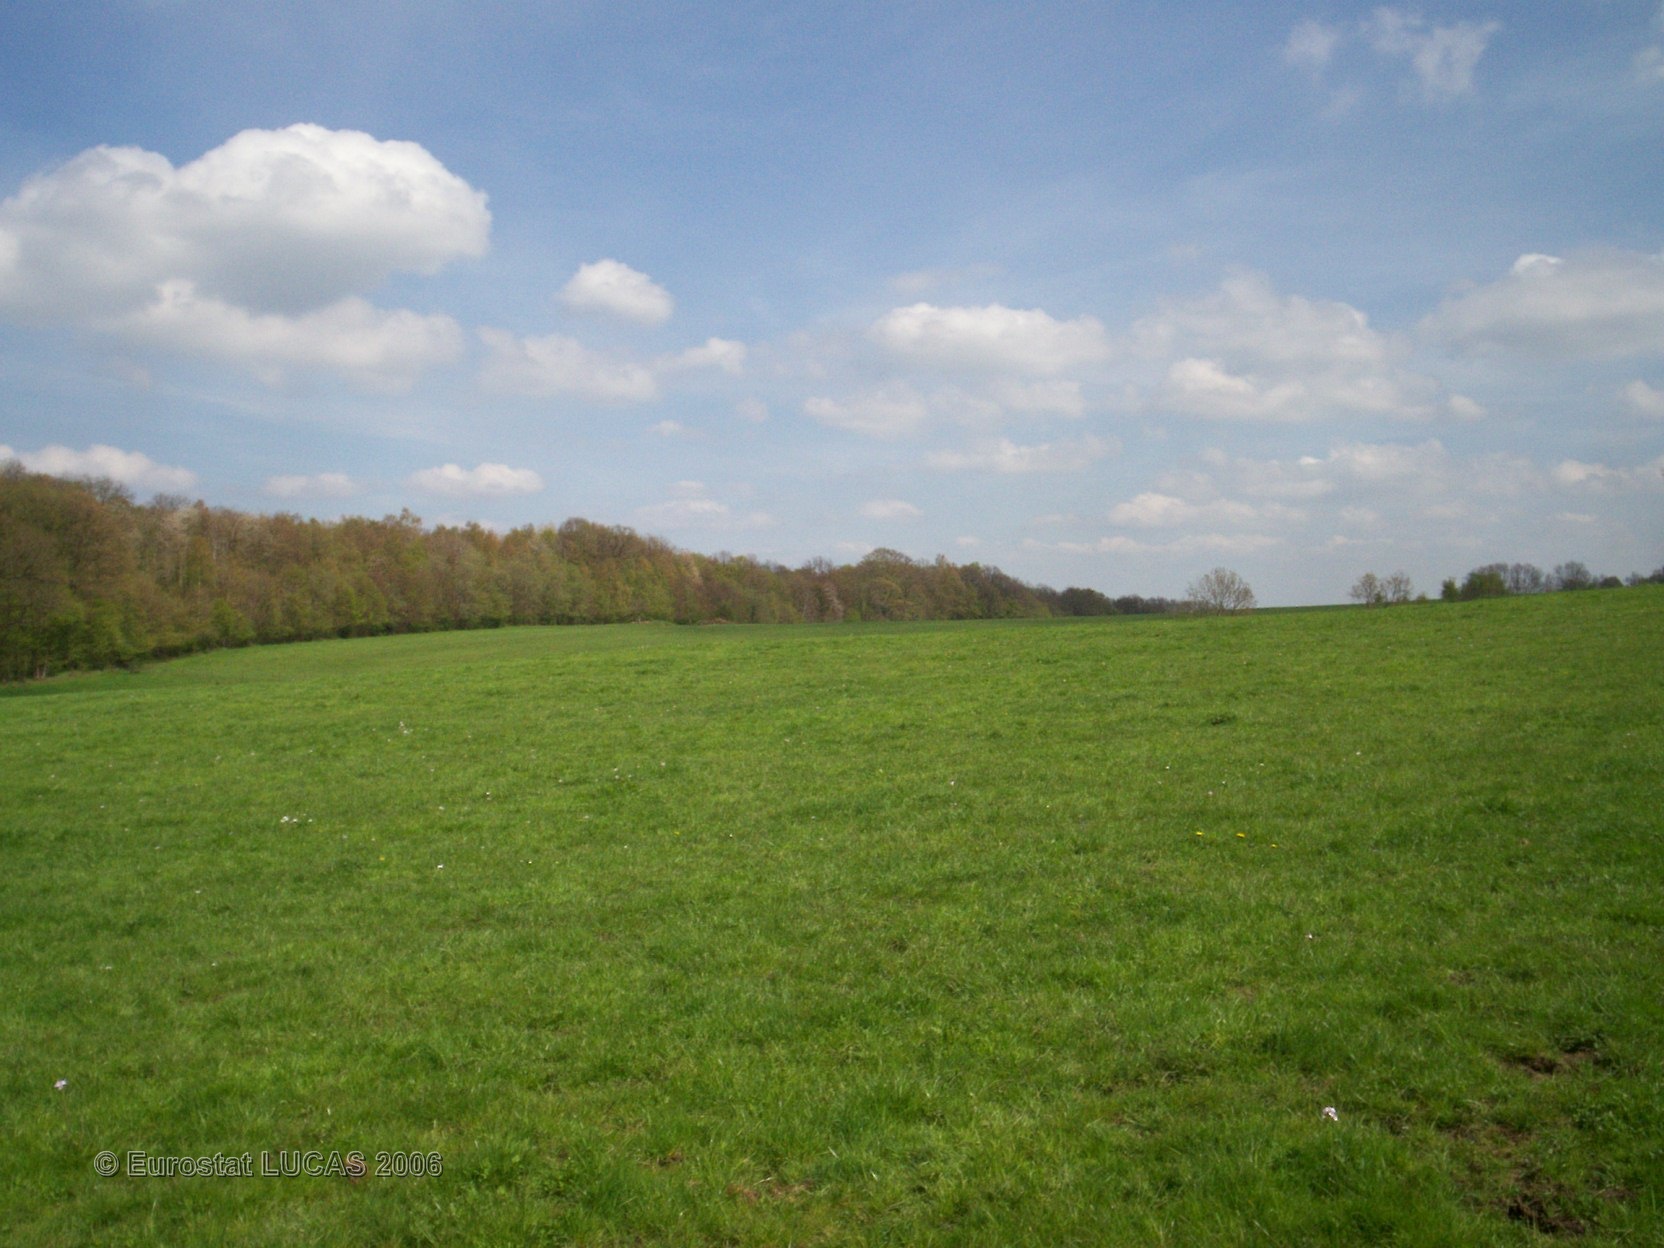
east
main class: Grassland
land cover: Grassland without tree/shrub cover
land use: Agriculture (excluding fallow land and kitchen gardens)
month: May
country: FR
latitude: 49.8286
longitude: 4.3655
